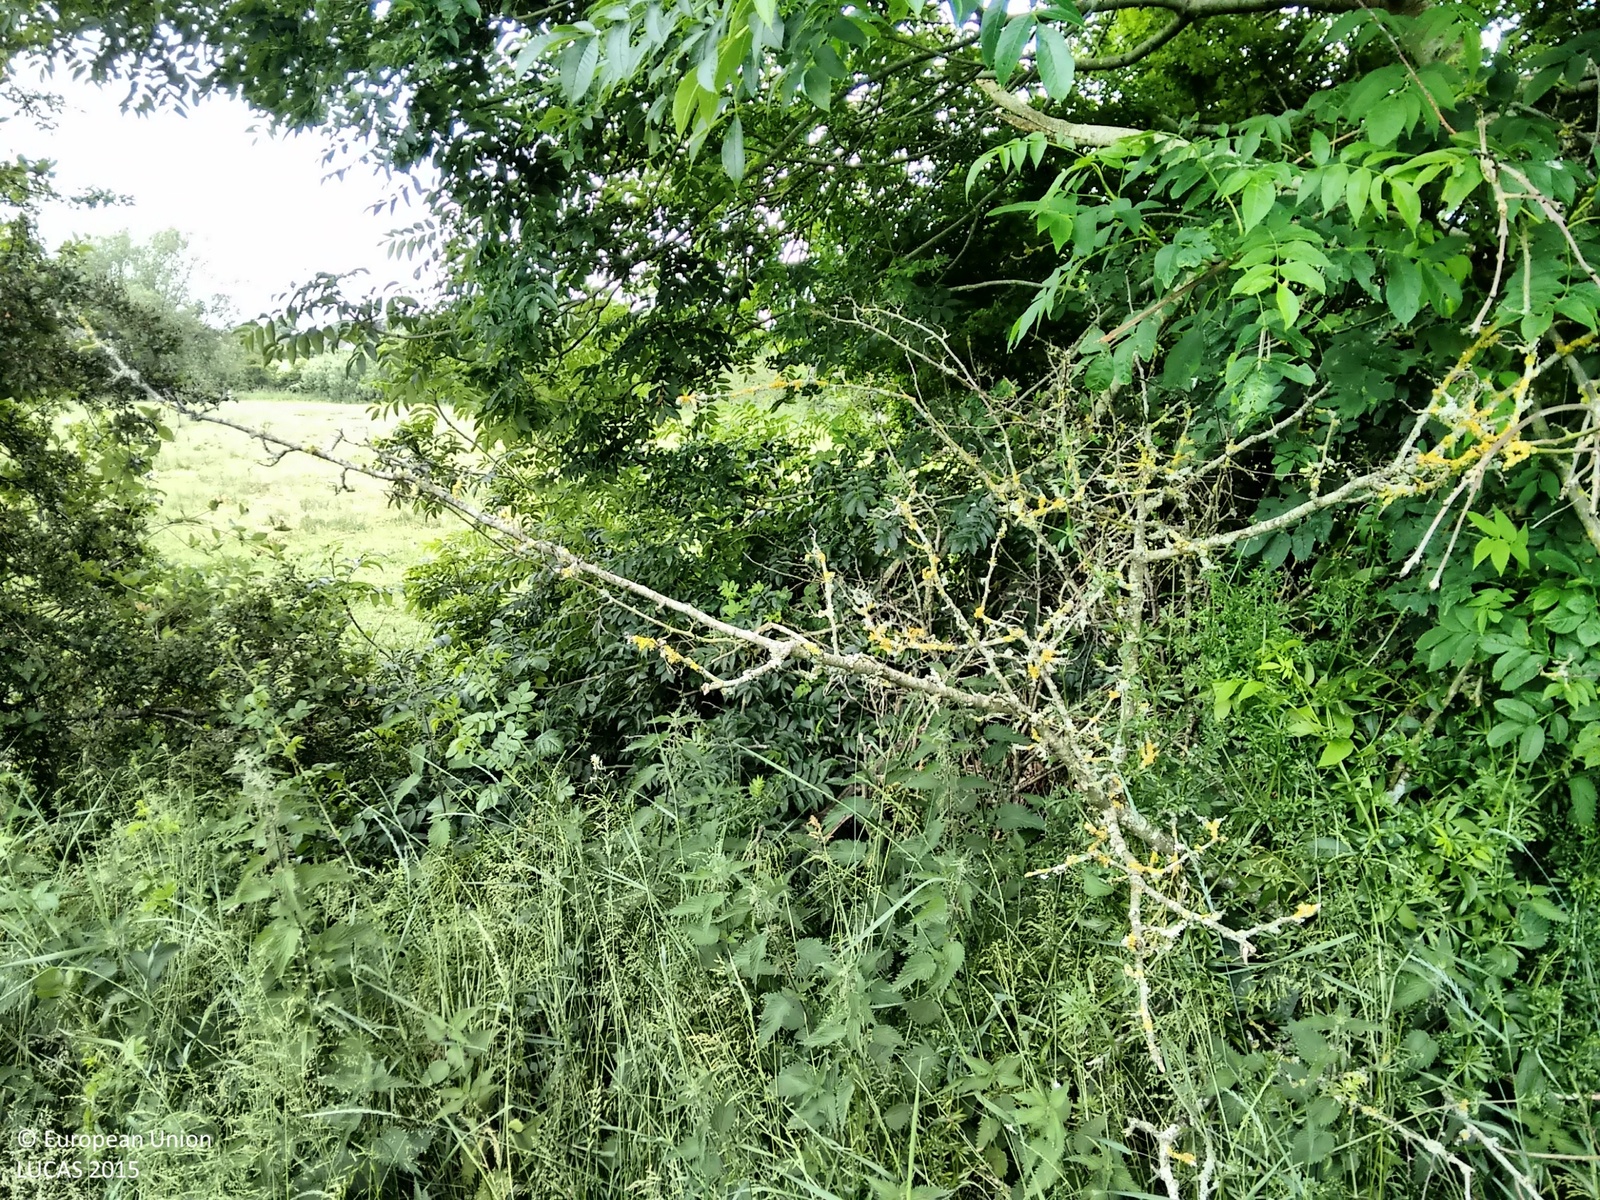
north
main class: Grassland
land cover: Grassland without tree/shrub cover
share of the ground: > 75 %
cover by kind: herbaceous plants 100 %
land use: Agriculture (excluding fallow land and kitchen gardens)
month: July
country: IE
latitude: 52.5302
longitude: -7.4179
